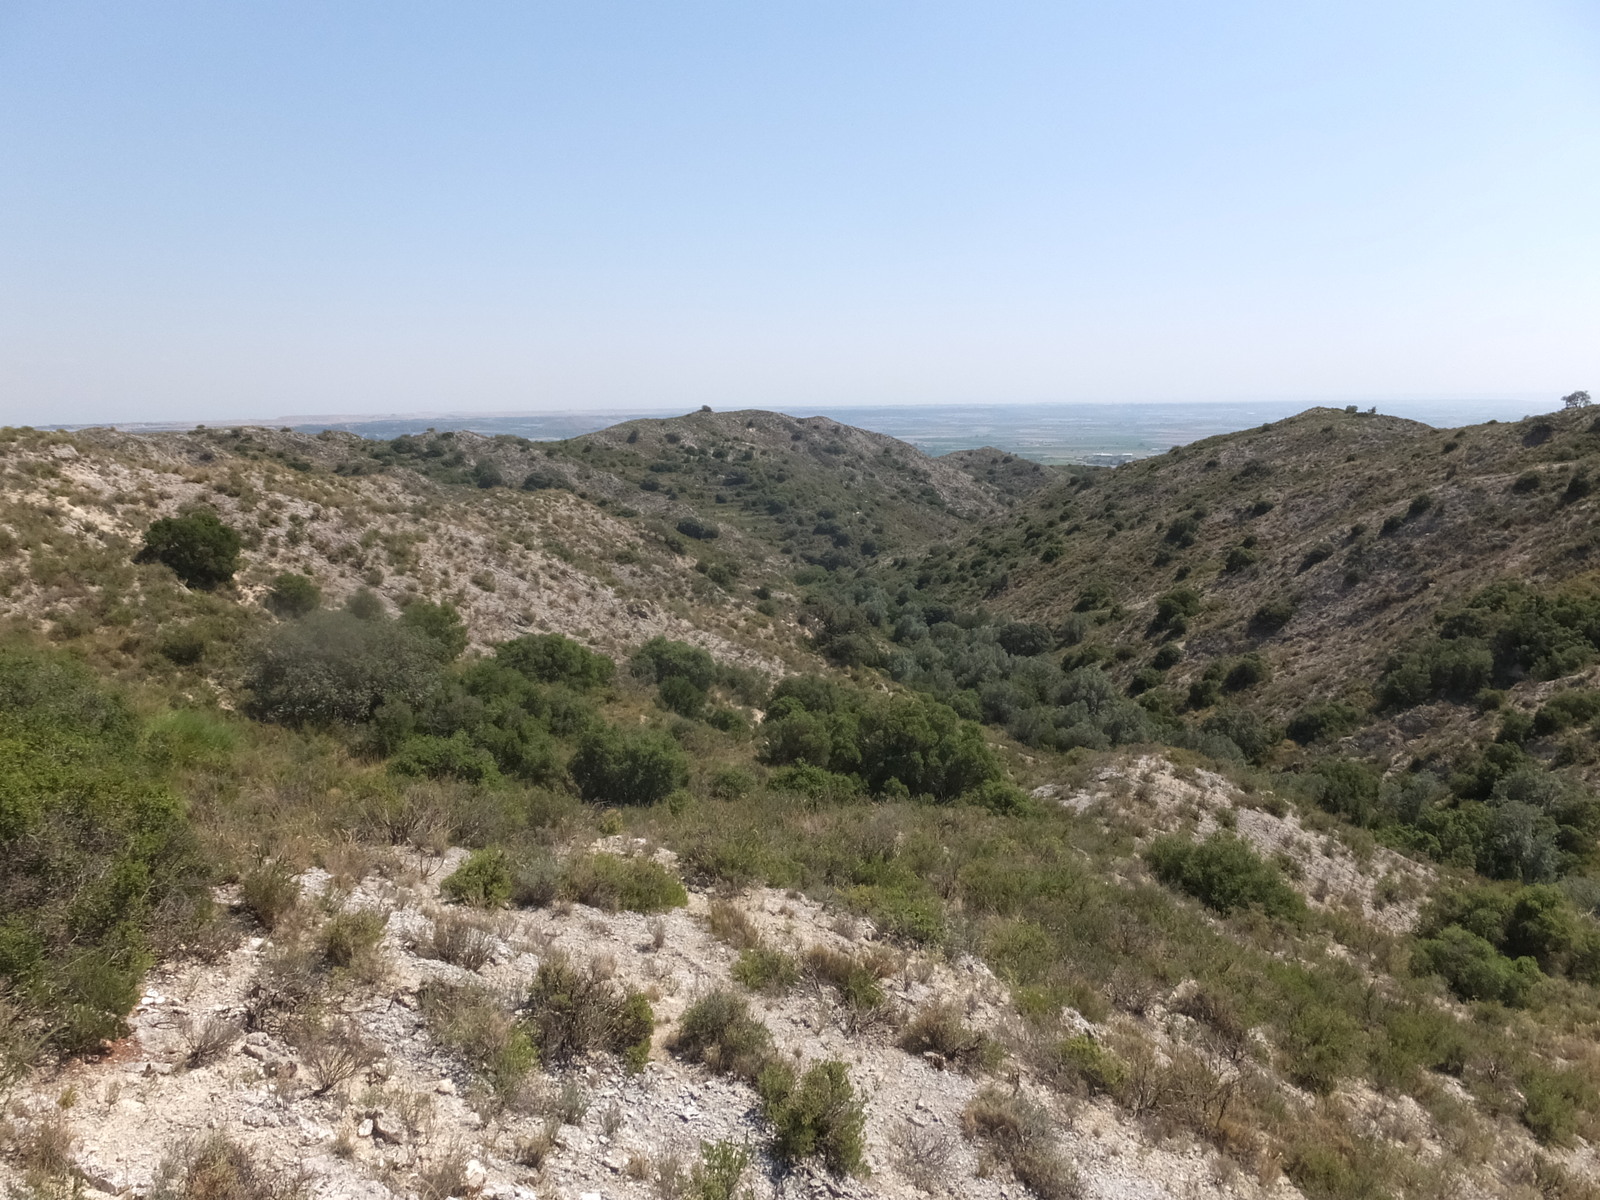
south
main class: Shrubland
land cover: Shrubland with sparse tree cover
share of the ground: 50 - 75 %
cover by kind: shrubs 50 %, herbaceous plants 25 %, consolidated bare surface 20 %, coniferous forest trees 5 %
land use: Semi-natural and natural areas not in use
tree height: < 5 m
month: June
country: ES
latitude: 41.8617
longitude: 0.5044
